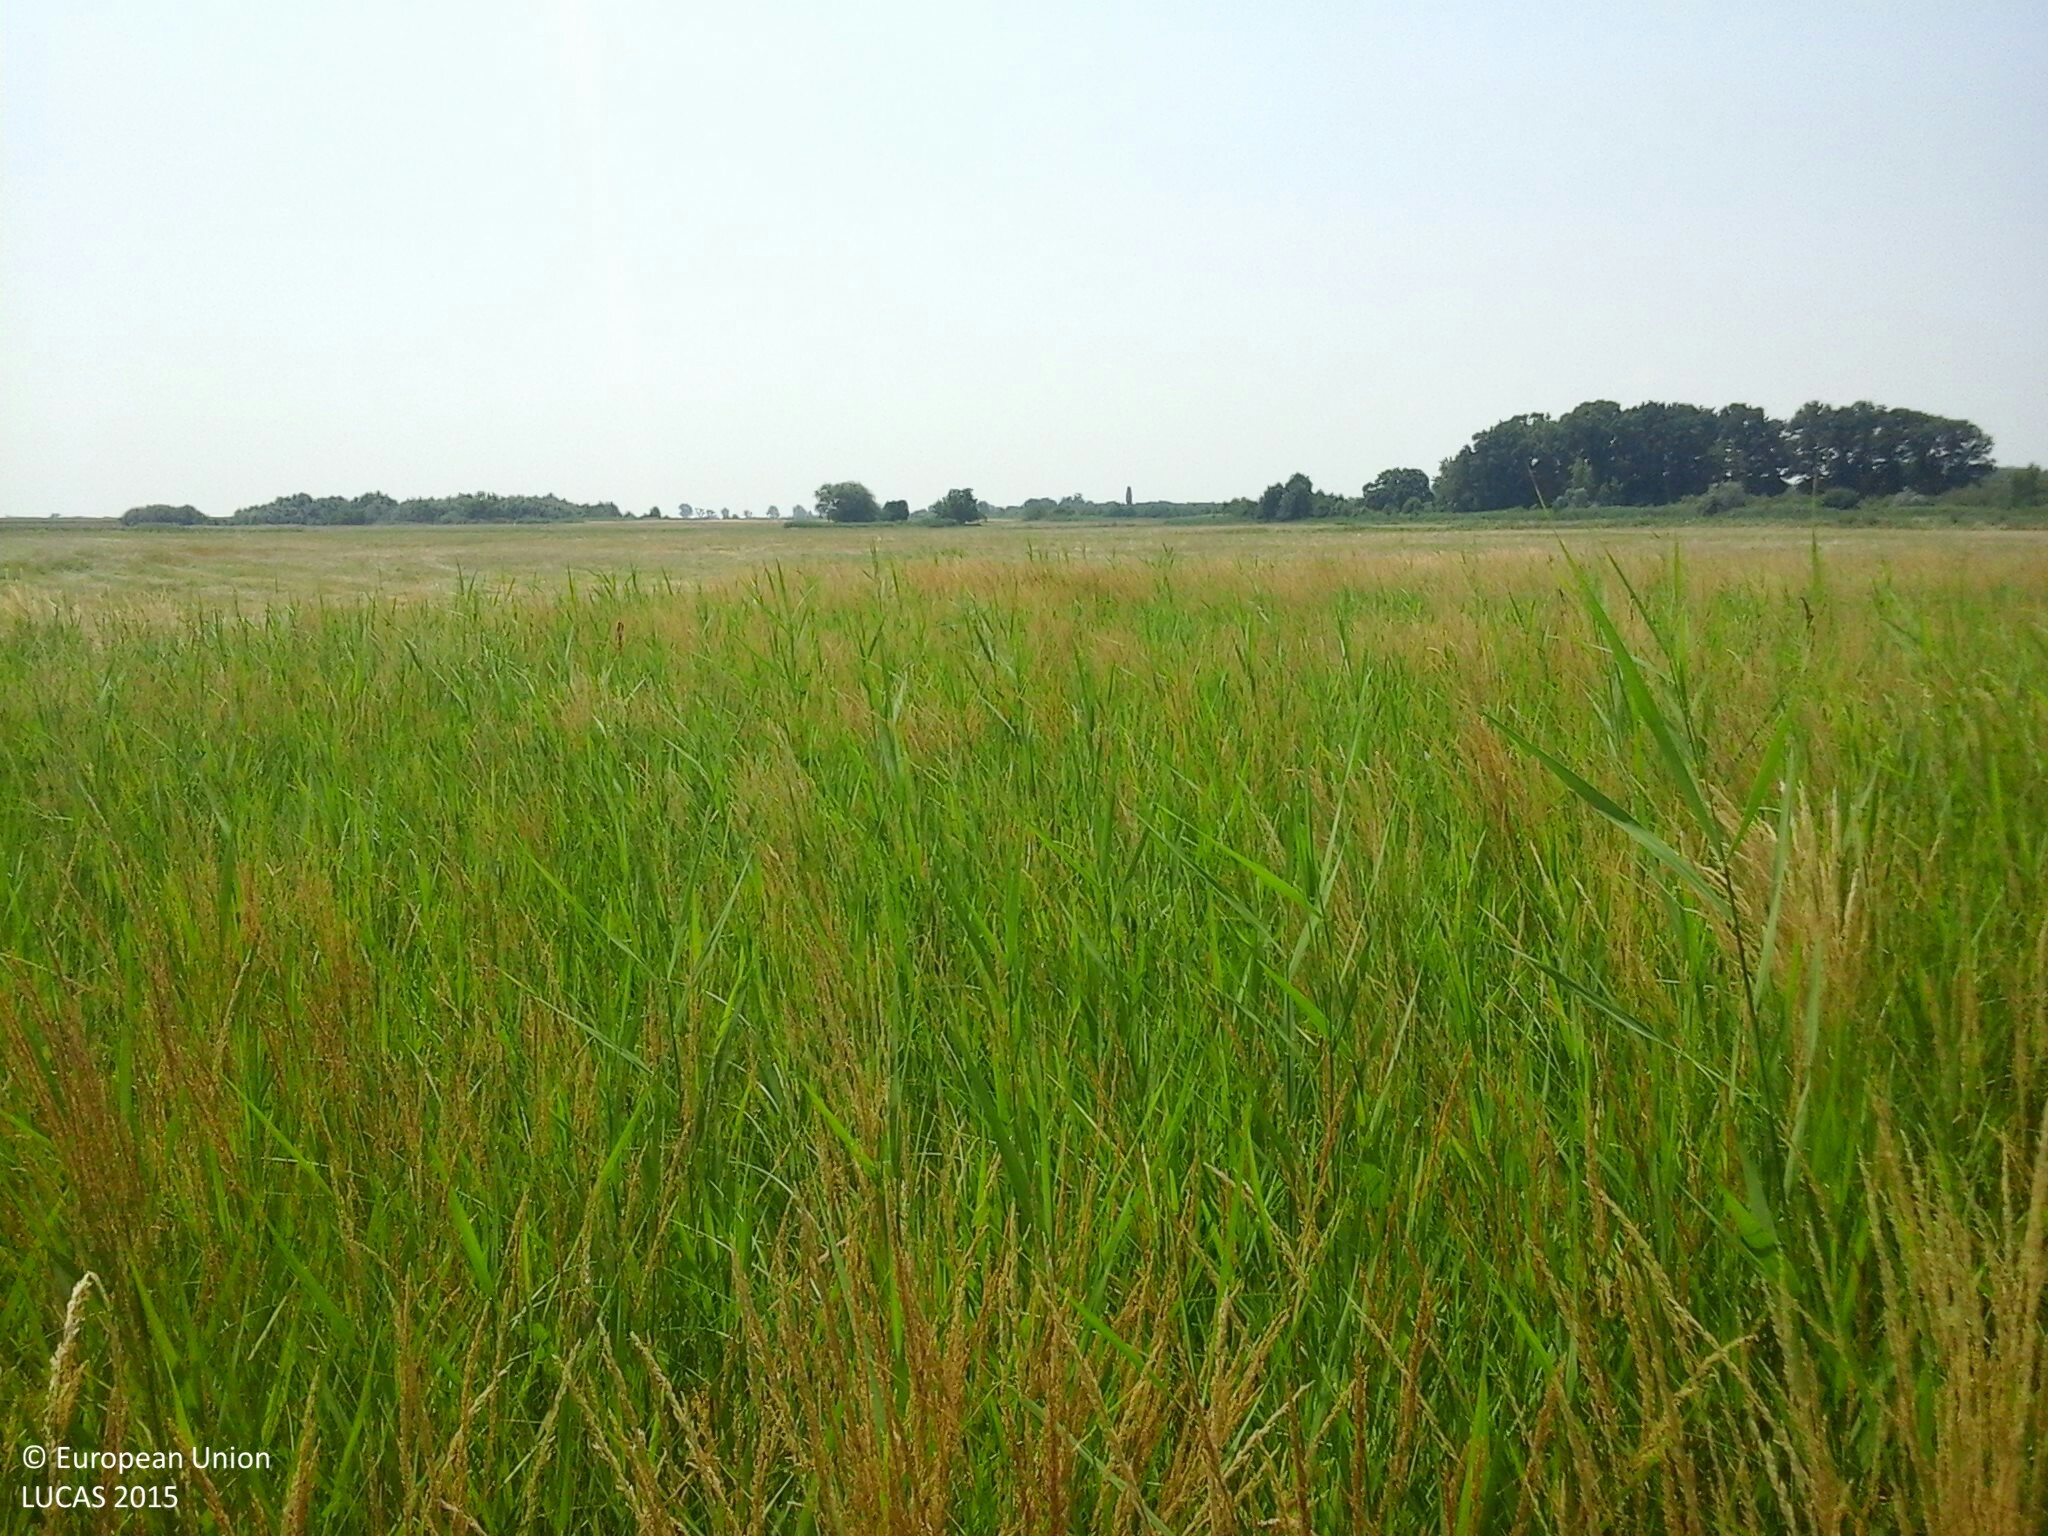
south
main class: Grassland
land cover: Grassland without tree/shrub cover
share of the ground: > 75 %
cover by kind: herbaceous plants 100 %
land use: Agriculture (excluding fallow land and kitchen gardens)
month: July
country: HU
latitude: 46.8434
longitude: 20.1875
